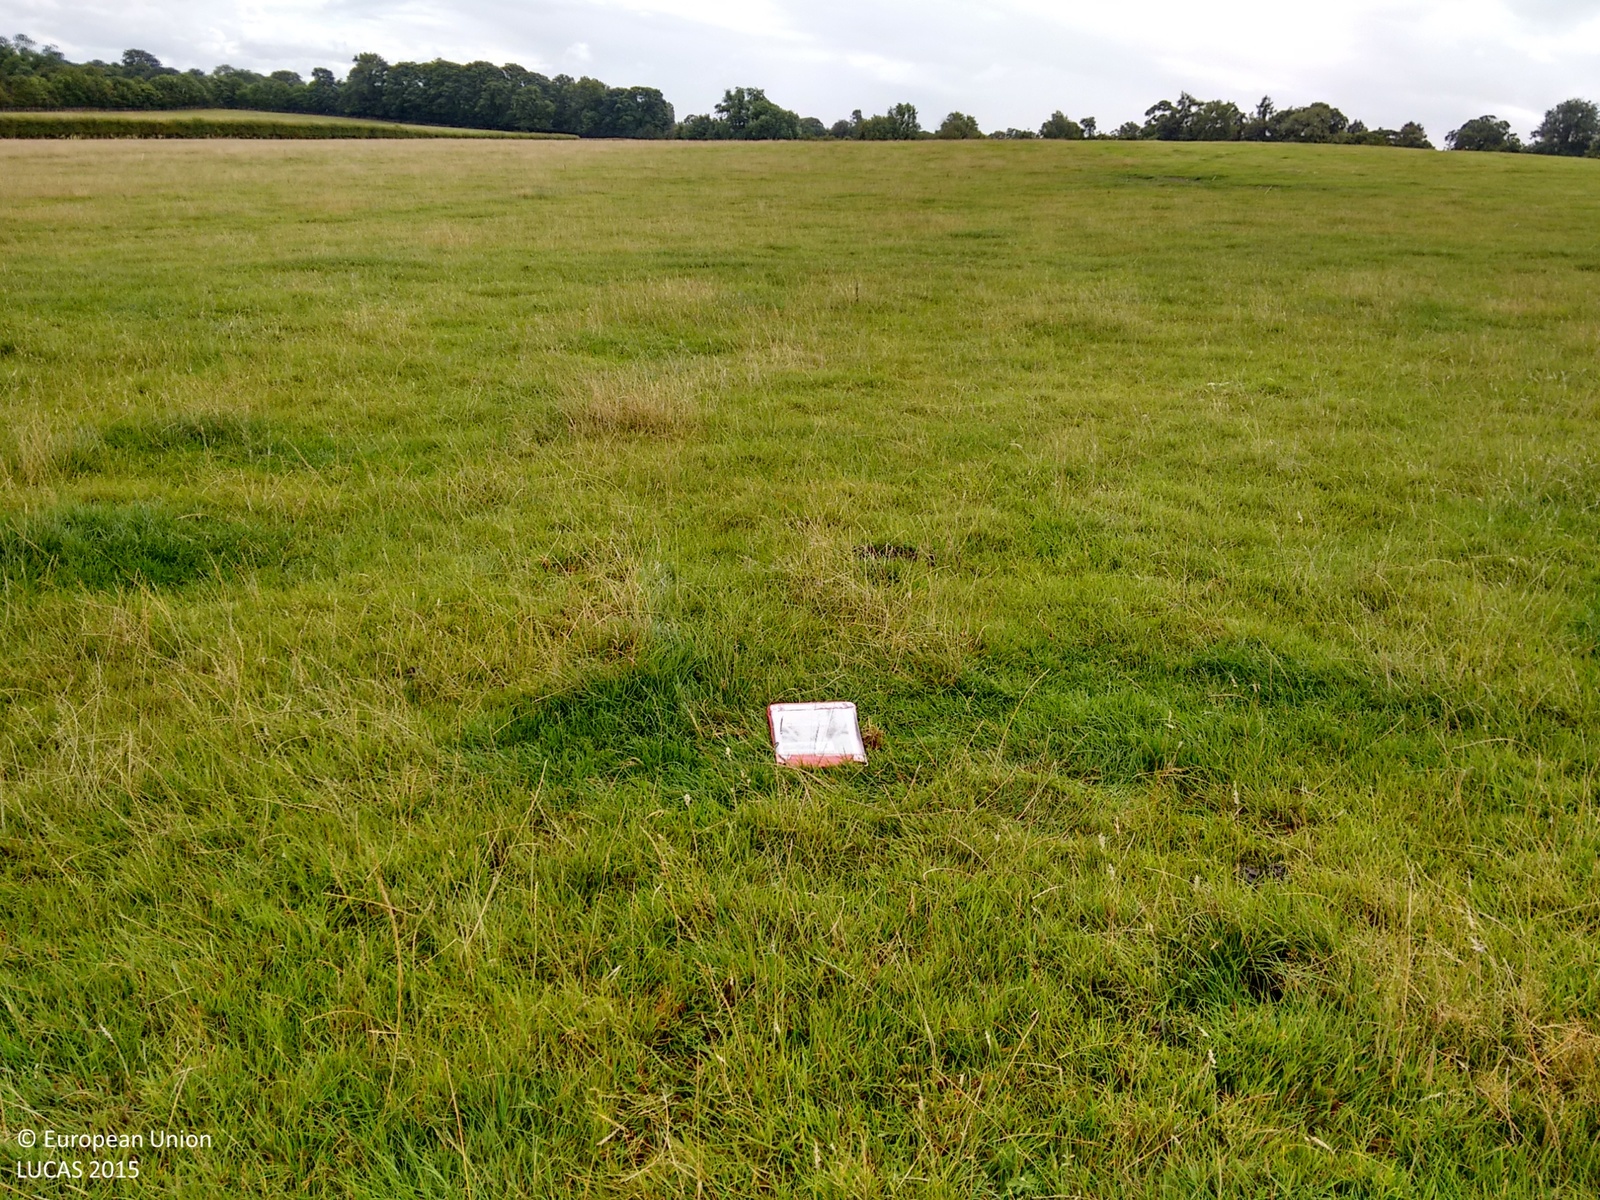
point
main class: Grassland
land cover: Grassland without tree/shrub cover
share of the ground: > 75 %
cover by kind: herbaceous plants 100 %
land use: Agriculture (excluding fallow land and kitchen gardens)
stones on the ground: < 10 %
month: September
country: GB
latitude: 53.0396
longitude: -3.0358
